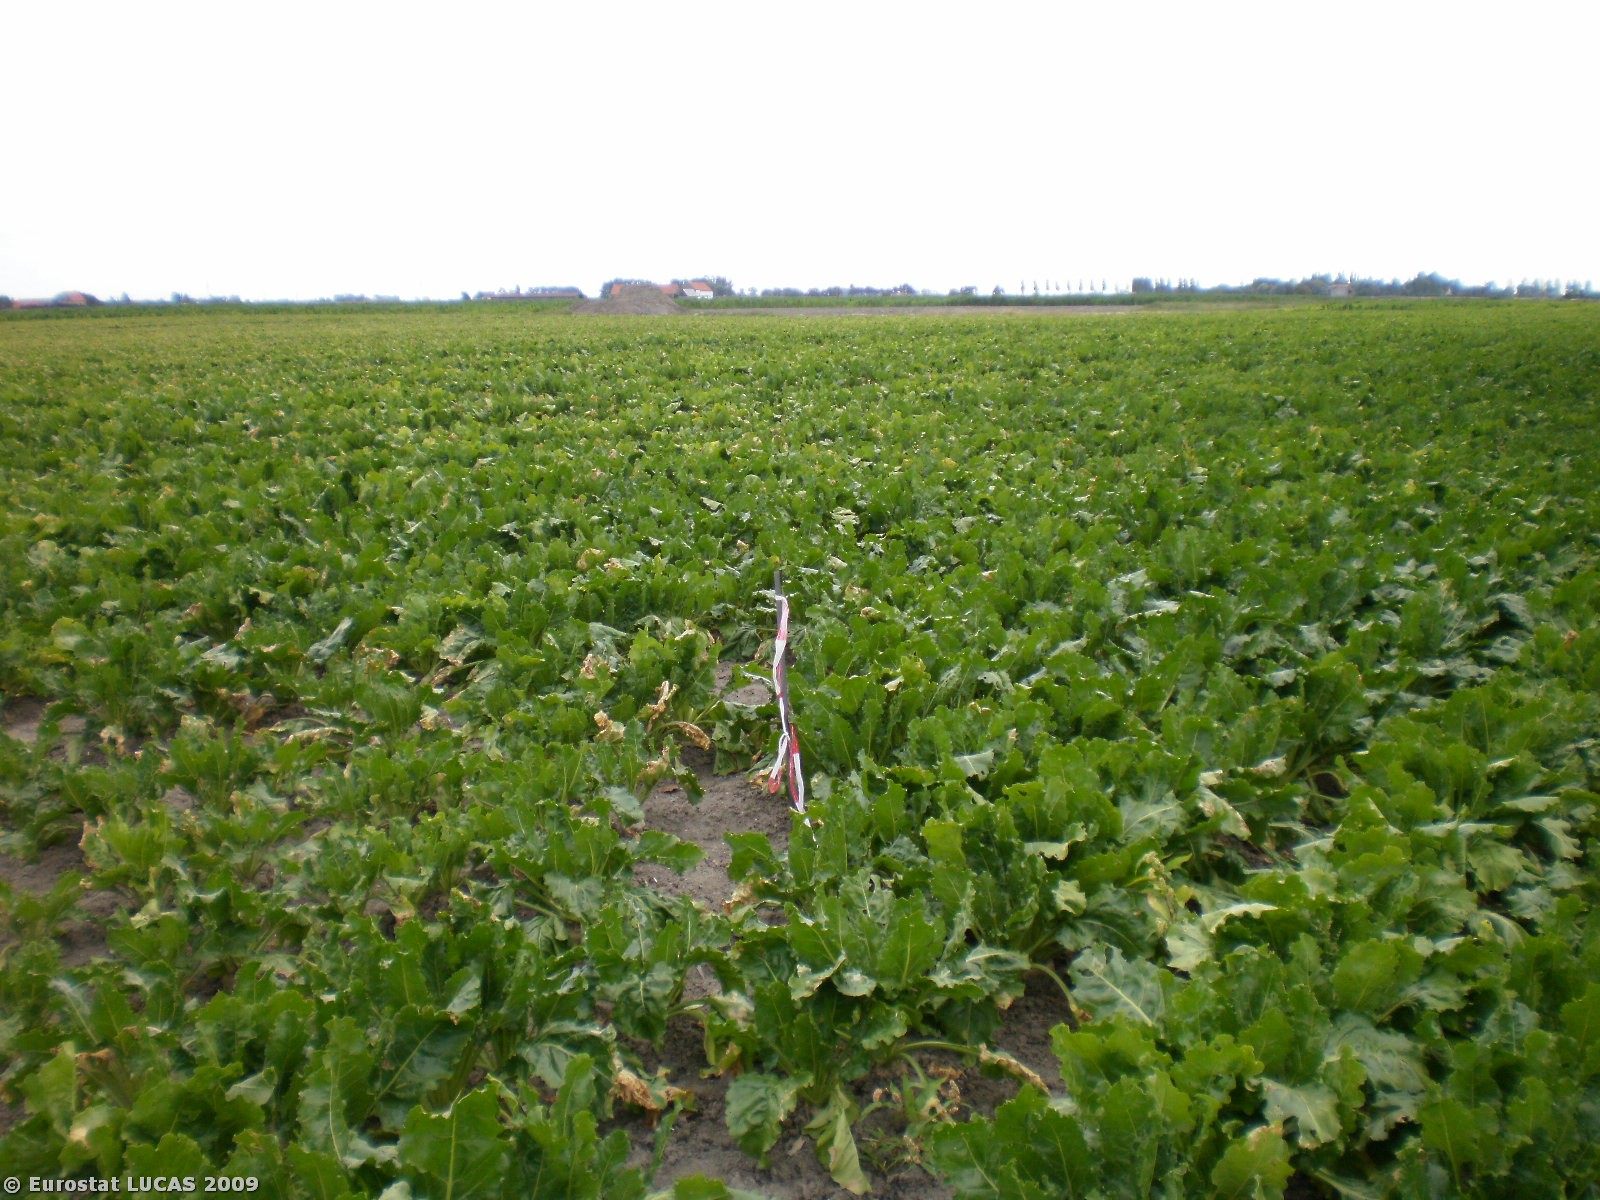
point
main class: Cropland
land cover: Sugar beet
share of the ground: 50 - 75 %
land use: Agriculture (excluding fallow land and kitchen gardens)
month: July
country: BE
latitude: 51.1103
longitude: 2.7754
